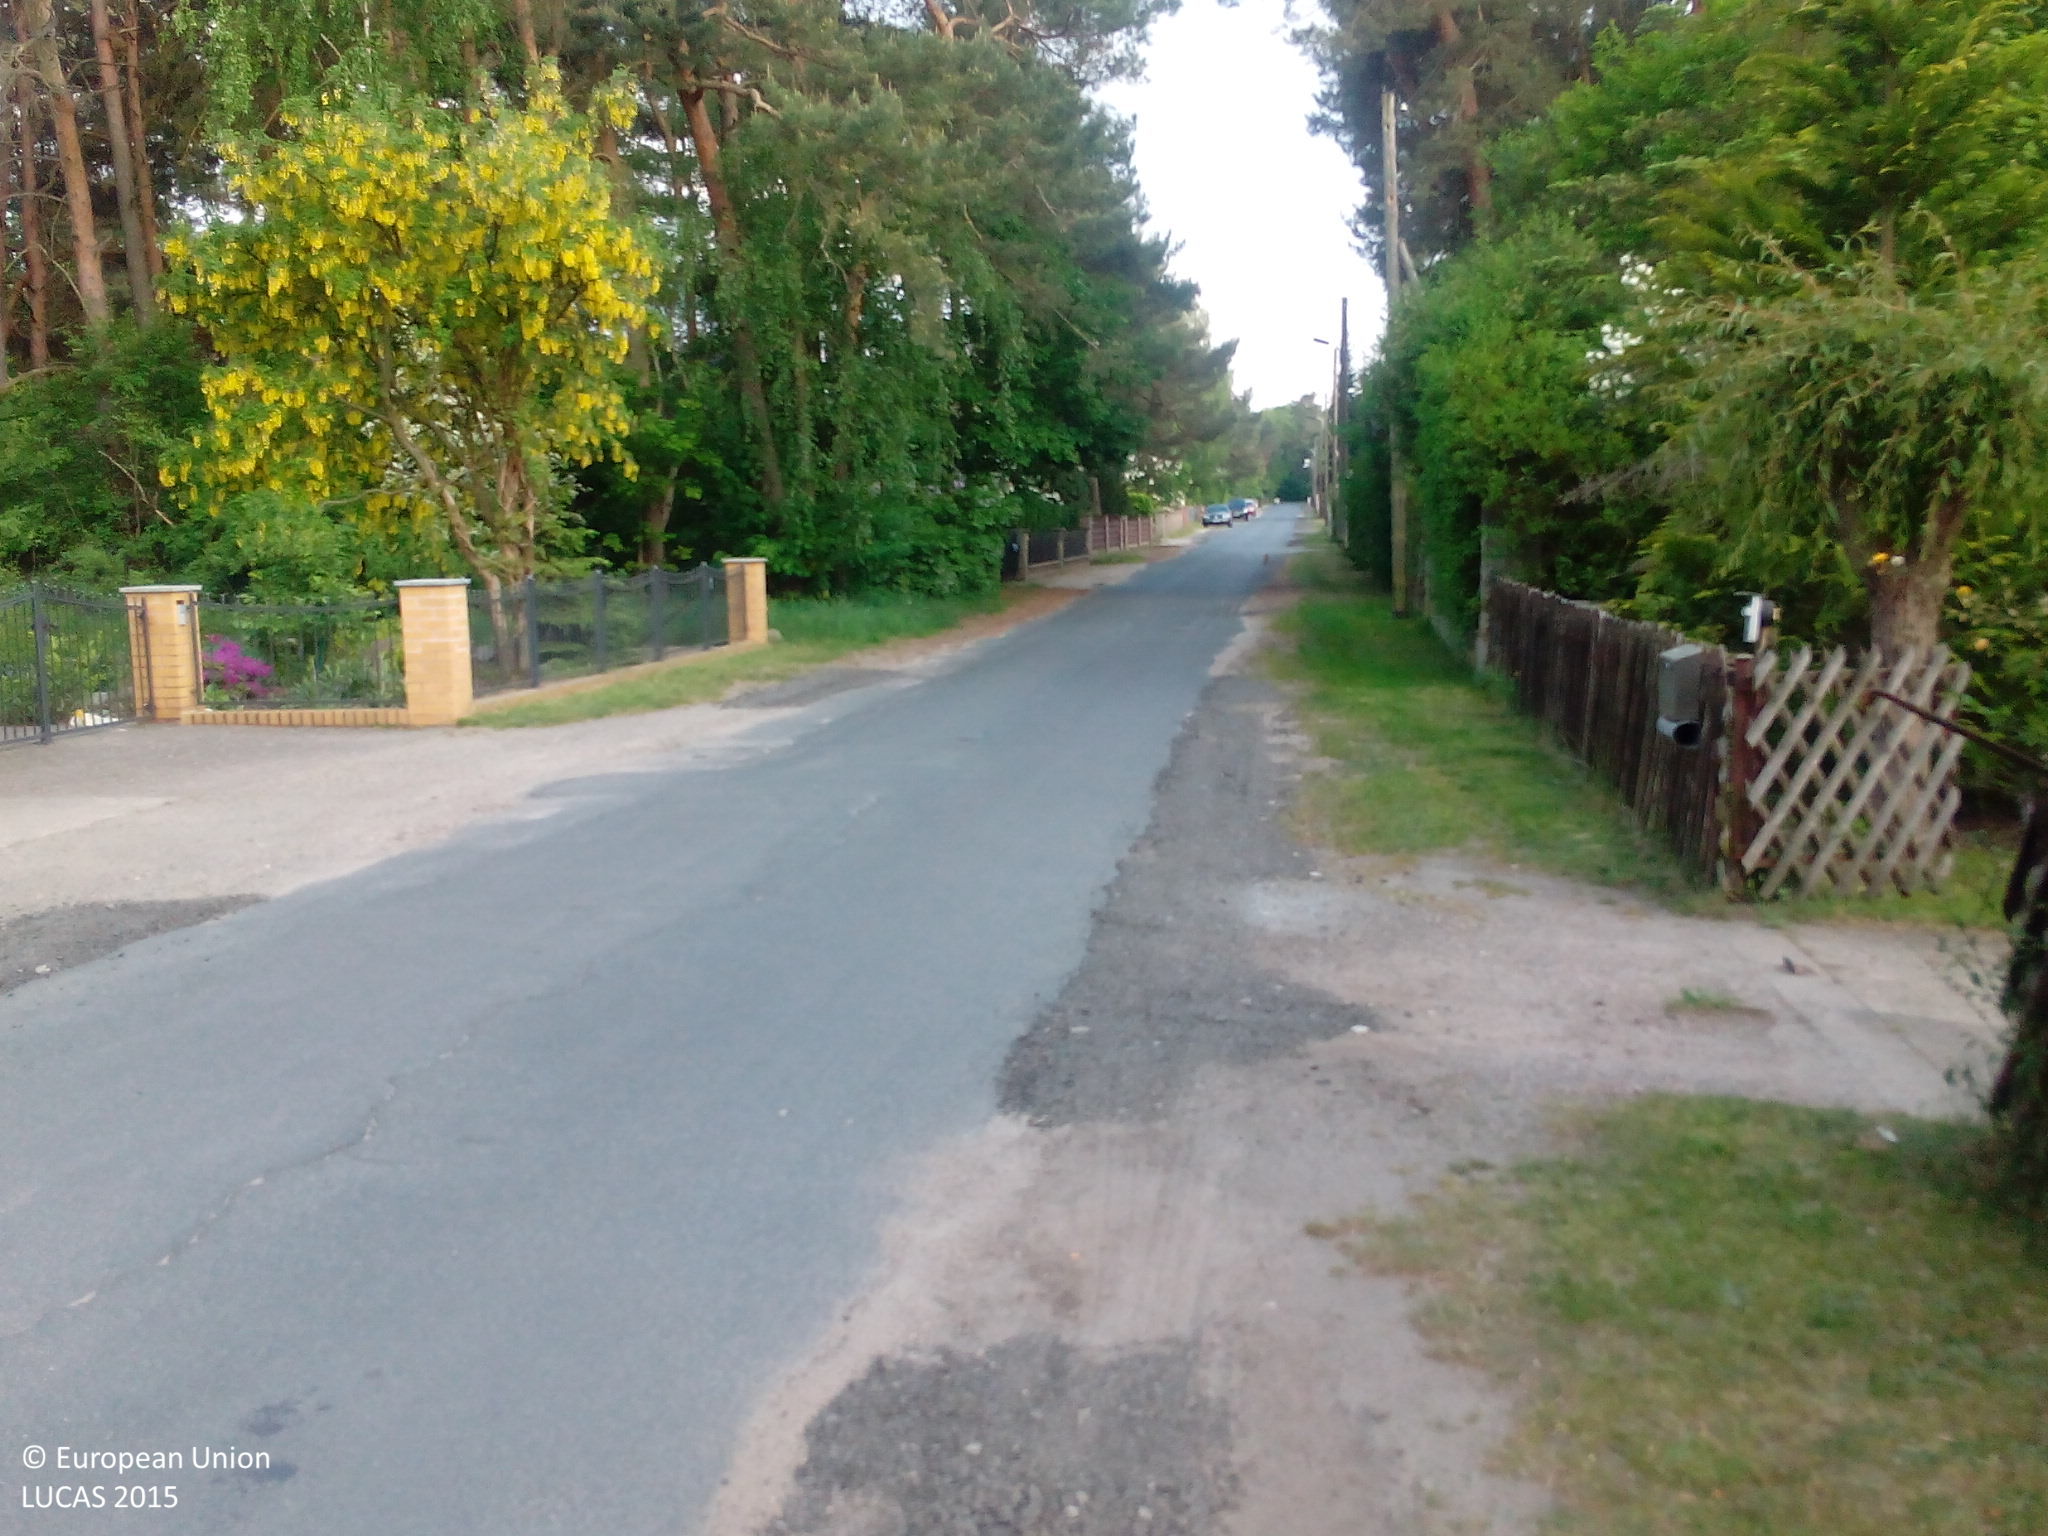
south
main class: Woodland
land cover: Pine dominated mixed woodland
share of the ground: 25 - 50 %
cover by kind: coniferous forest trees 25 %, broadleaved forest trees 25 %, consolidated bare surface 25 %, herbaceous plants 15 %, shrubs 10 %
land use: Residential
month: May
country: DE
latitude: 52.1022
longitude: 13.1388
